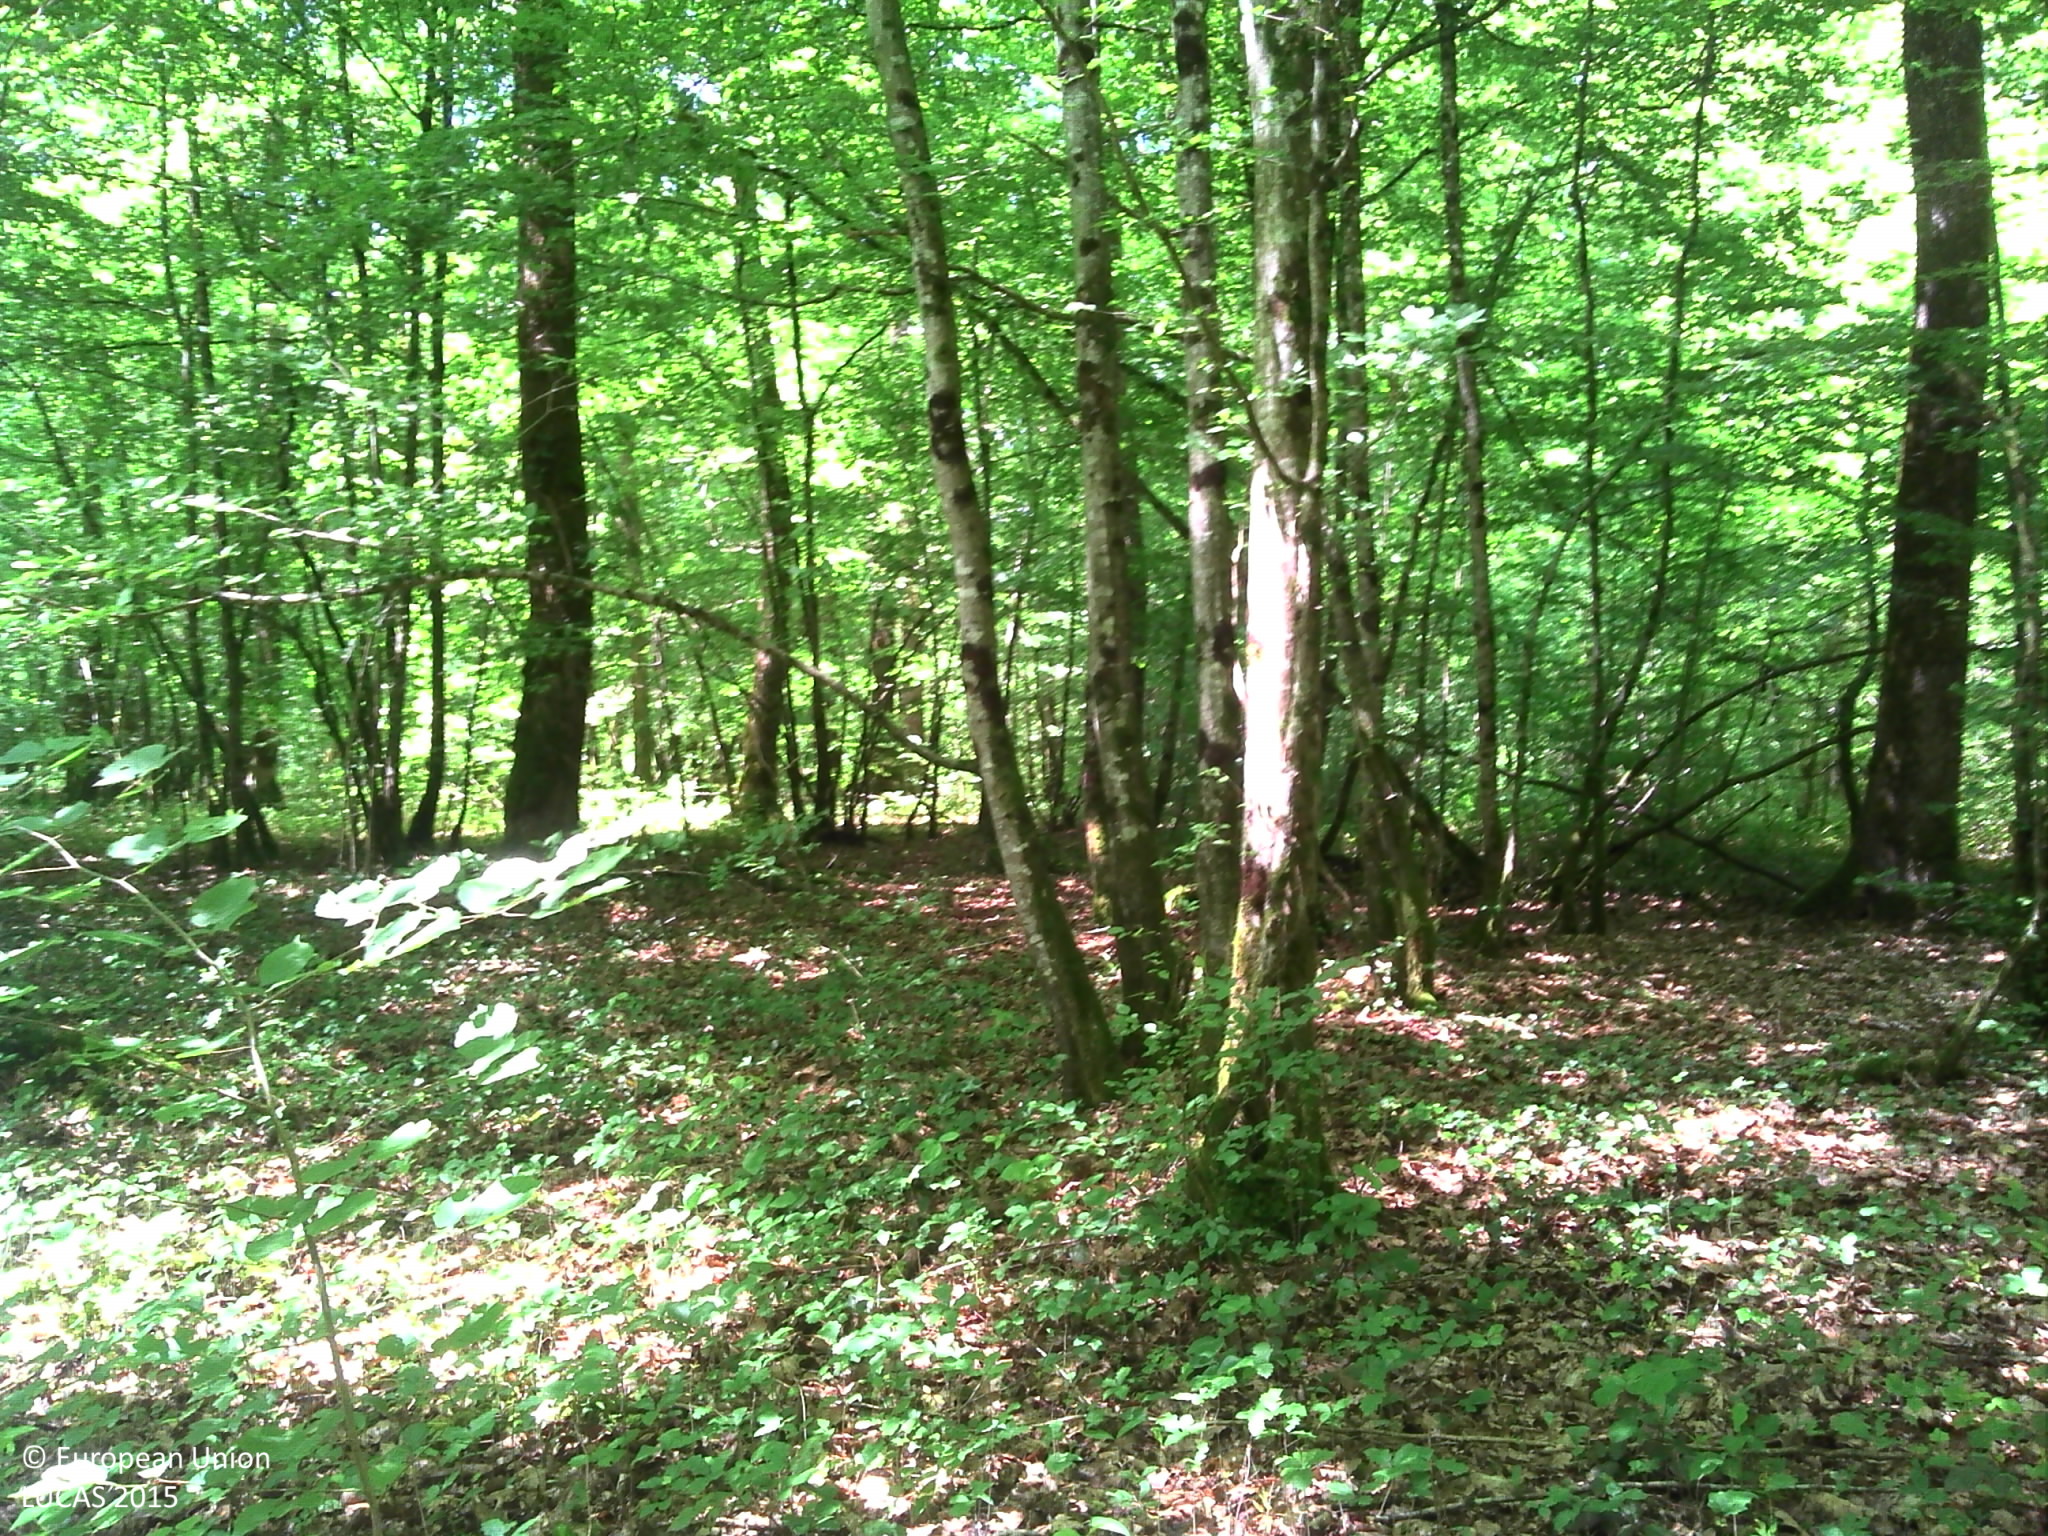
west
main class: Woodland
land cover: Broadleaved woodland
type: beech forest
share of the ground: > 75 %
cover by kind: broadleaved forest trees 90 %, herbaceous plants 10 %
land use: Forestry
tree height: > 5 m
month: June
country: FR
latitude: 48.5261
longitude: 5.0290
